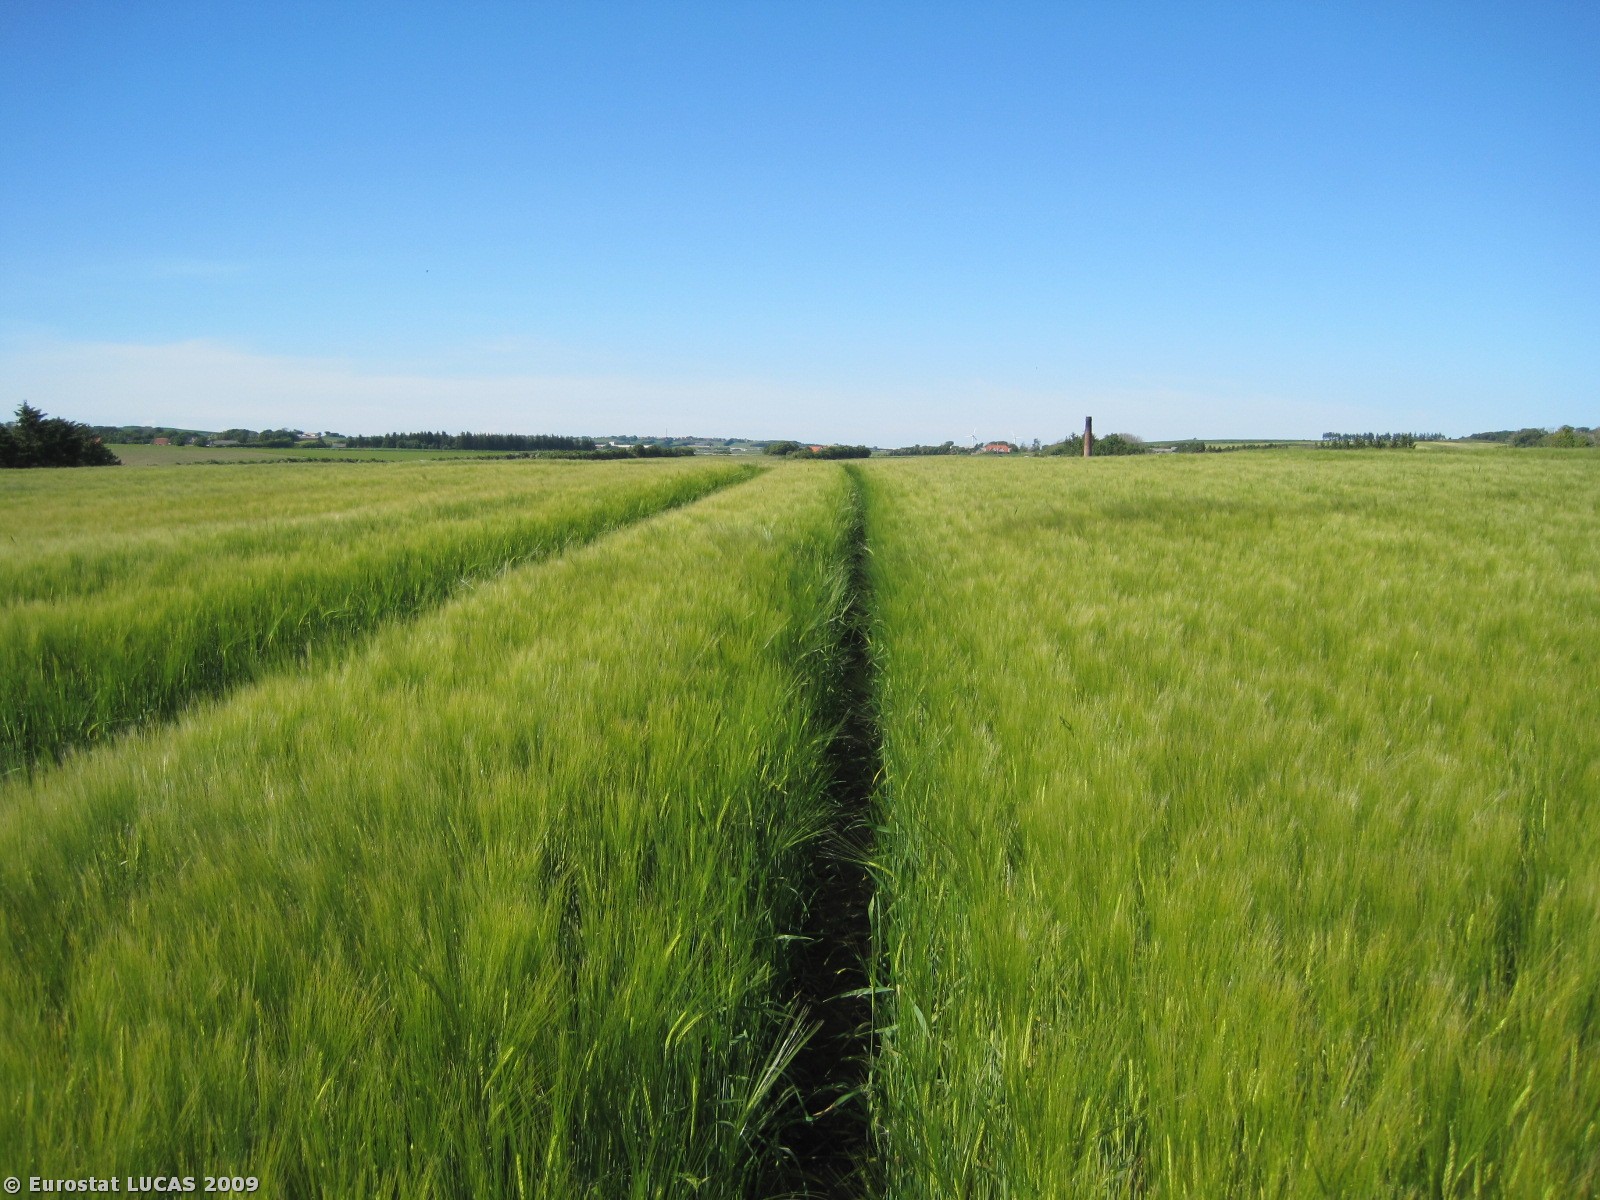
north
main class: Cropland
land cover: Barley
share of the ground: > 75 %
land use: Agriculture (excluding fallow land and kitchen gardens)
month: June
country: DK
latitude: 57.5181
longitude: 10.0167
